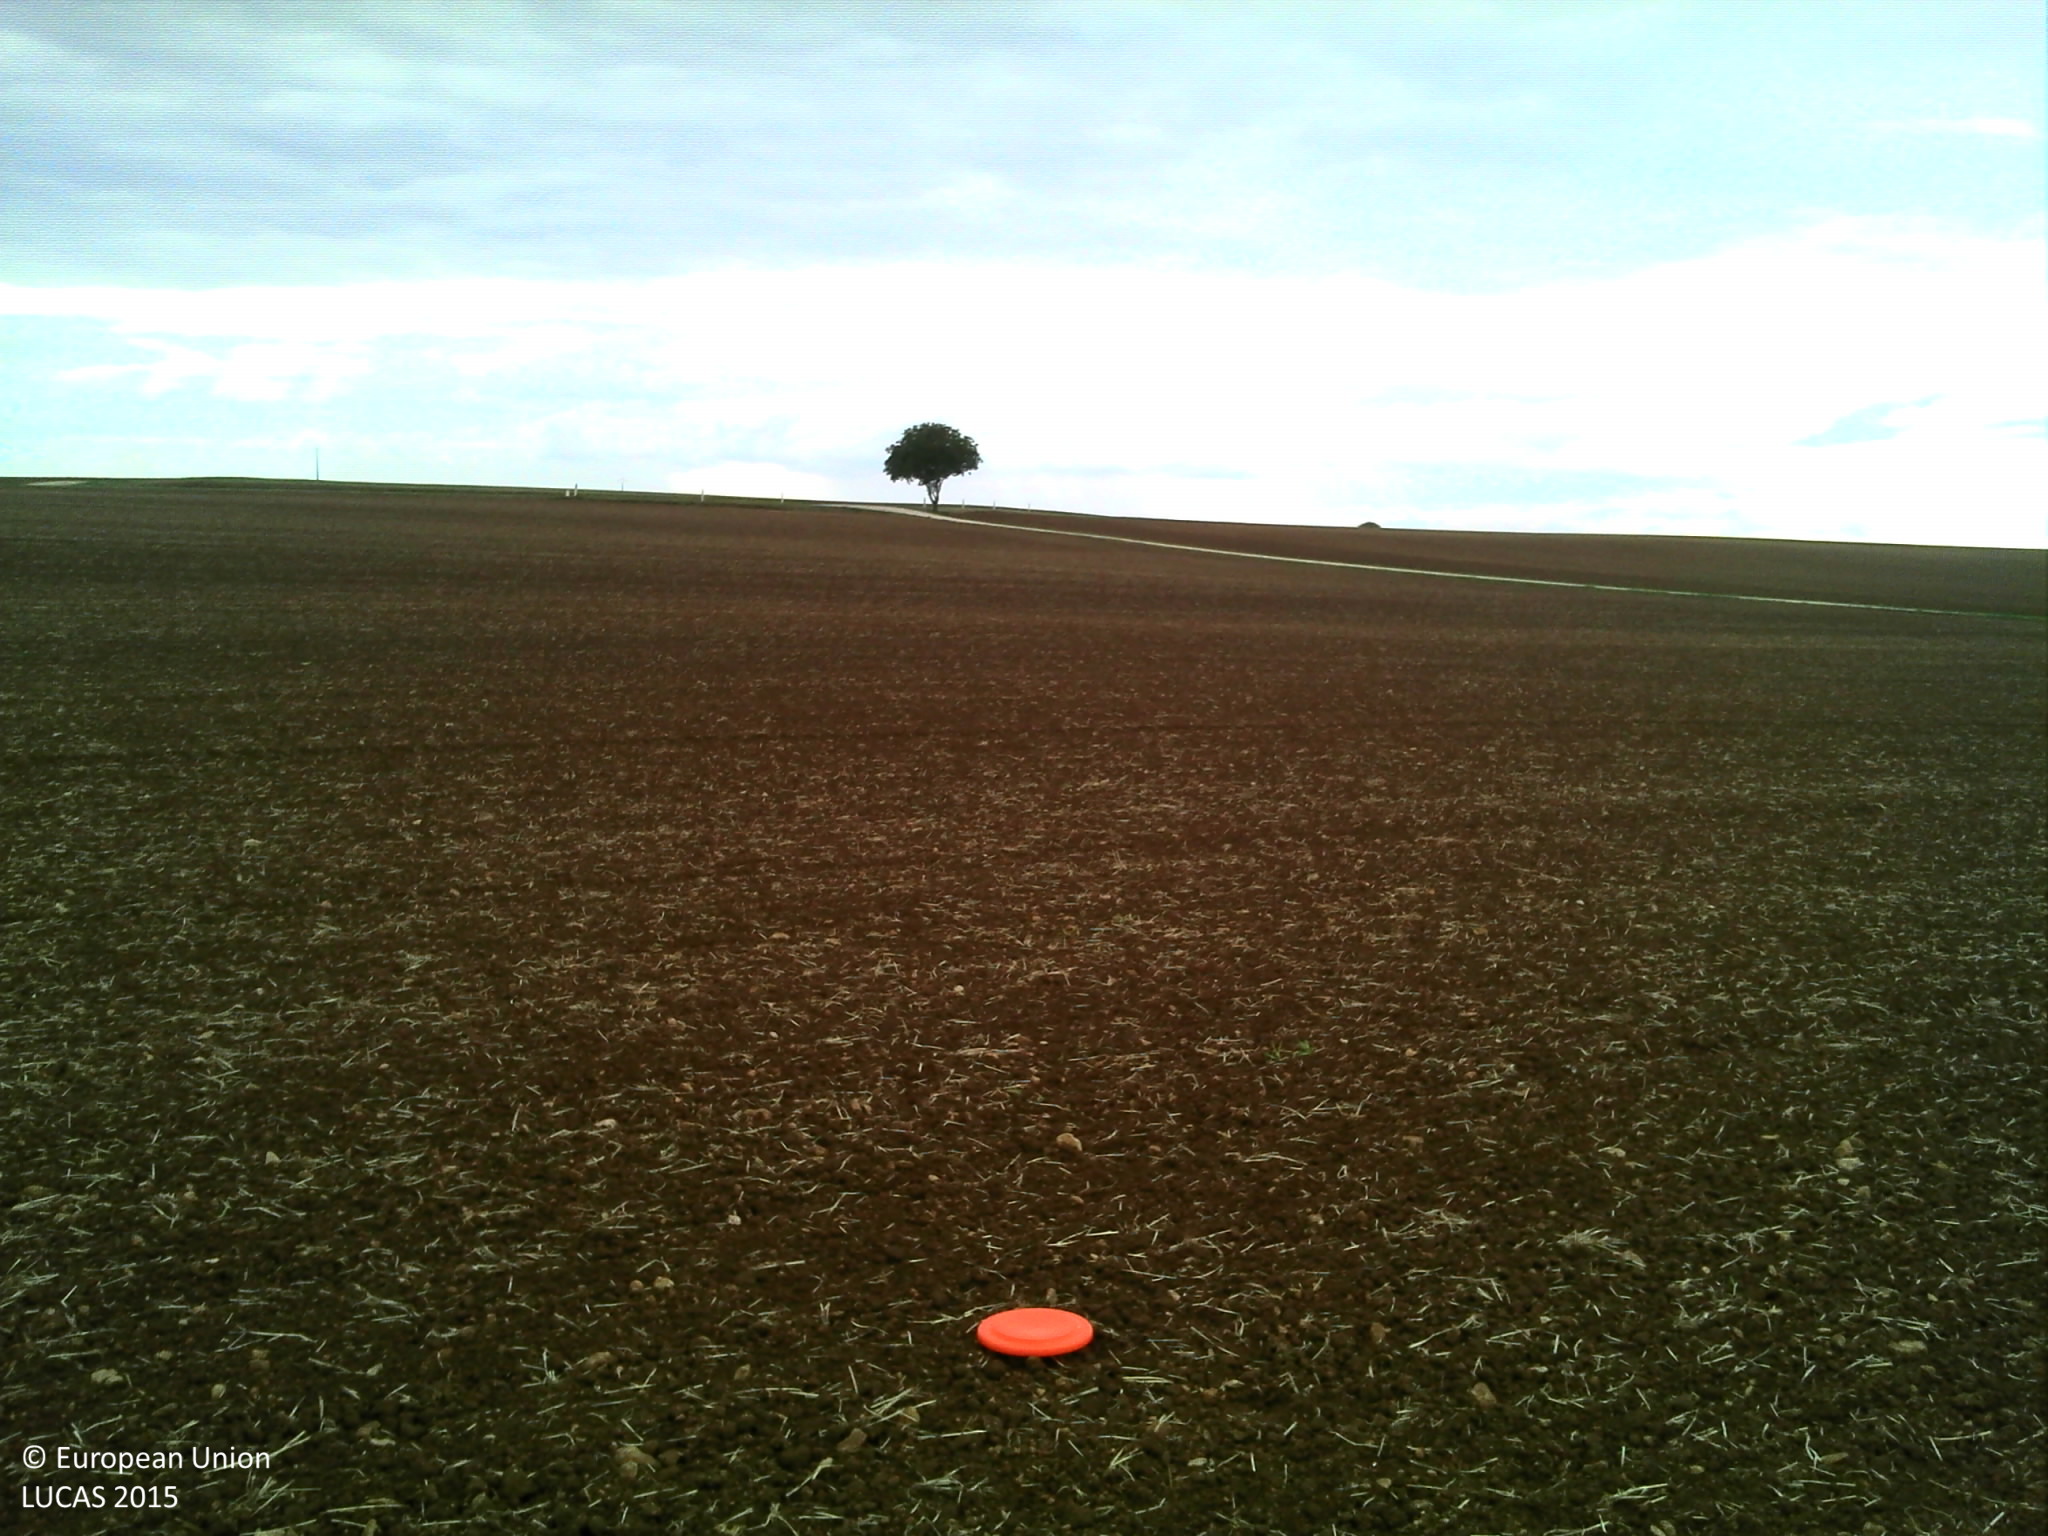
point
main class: Cropland
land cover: Barley
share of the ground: 25 - 50 %
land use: Agriculture (excluding fallow land and kitchen gardens)
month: September
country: FR
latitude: 47.7390
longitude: 4.4107
